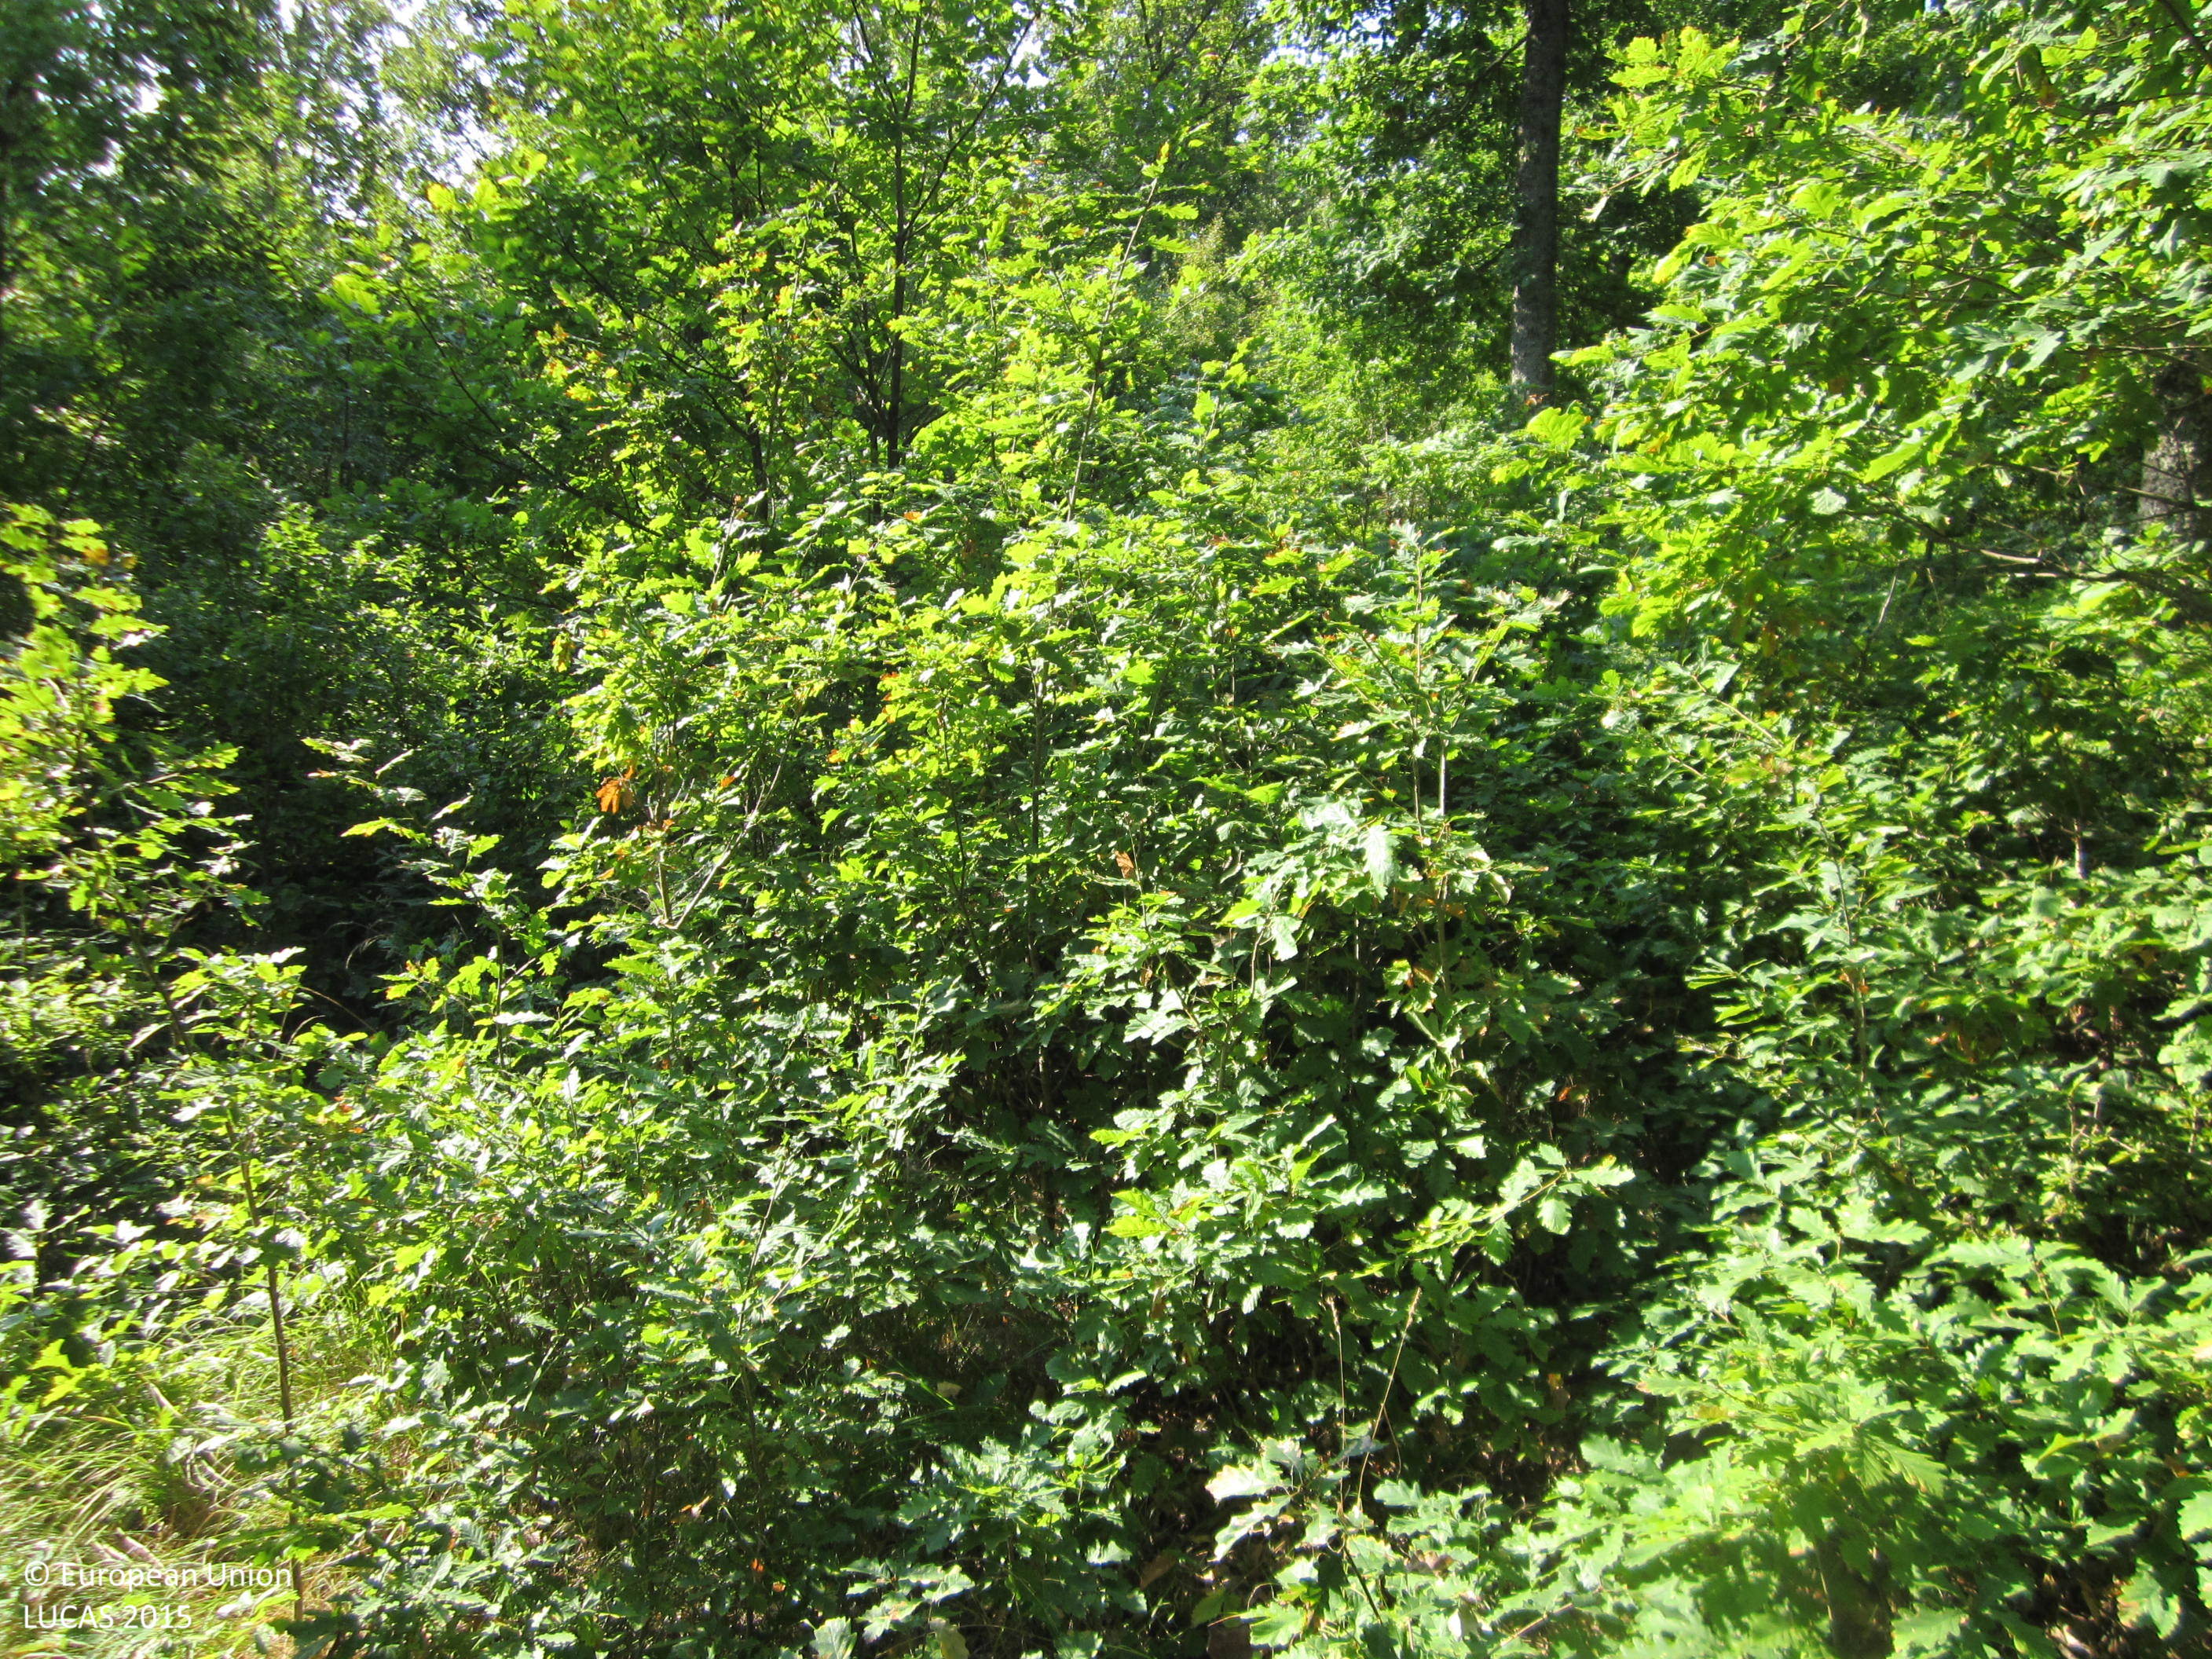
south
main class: Woodland
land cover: Broadleaved woodland
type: mesophytic deciduous forest
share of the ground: > 75 %
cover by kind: broadleaved forest trees 85 %, herbaceous plants 10 %, shrubs 5 %
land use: Forestry
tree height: > 5 m
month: September
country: BG
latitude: 42.8630
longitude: 27.3143
